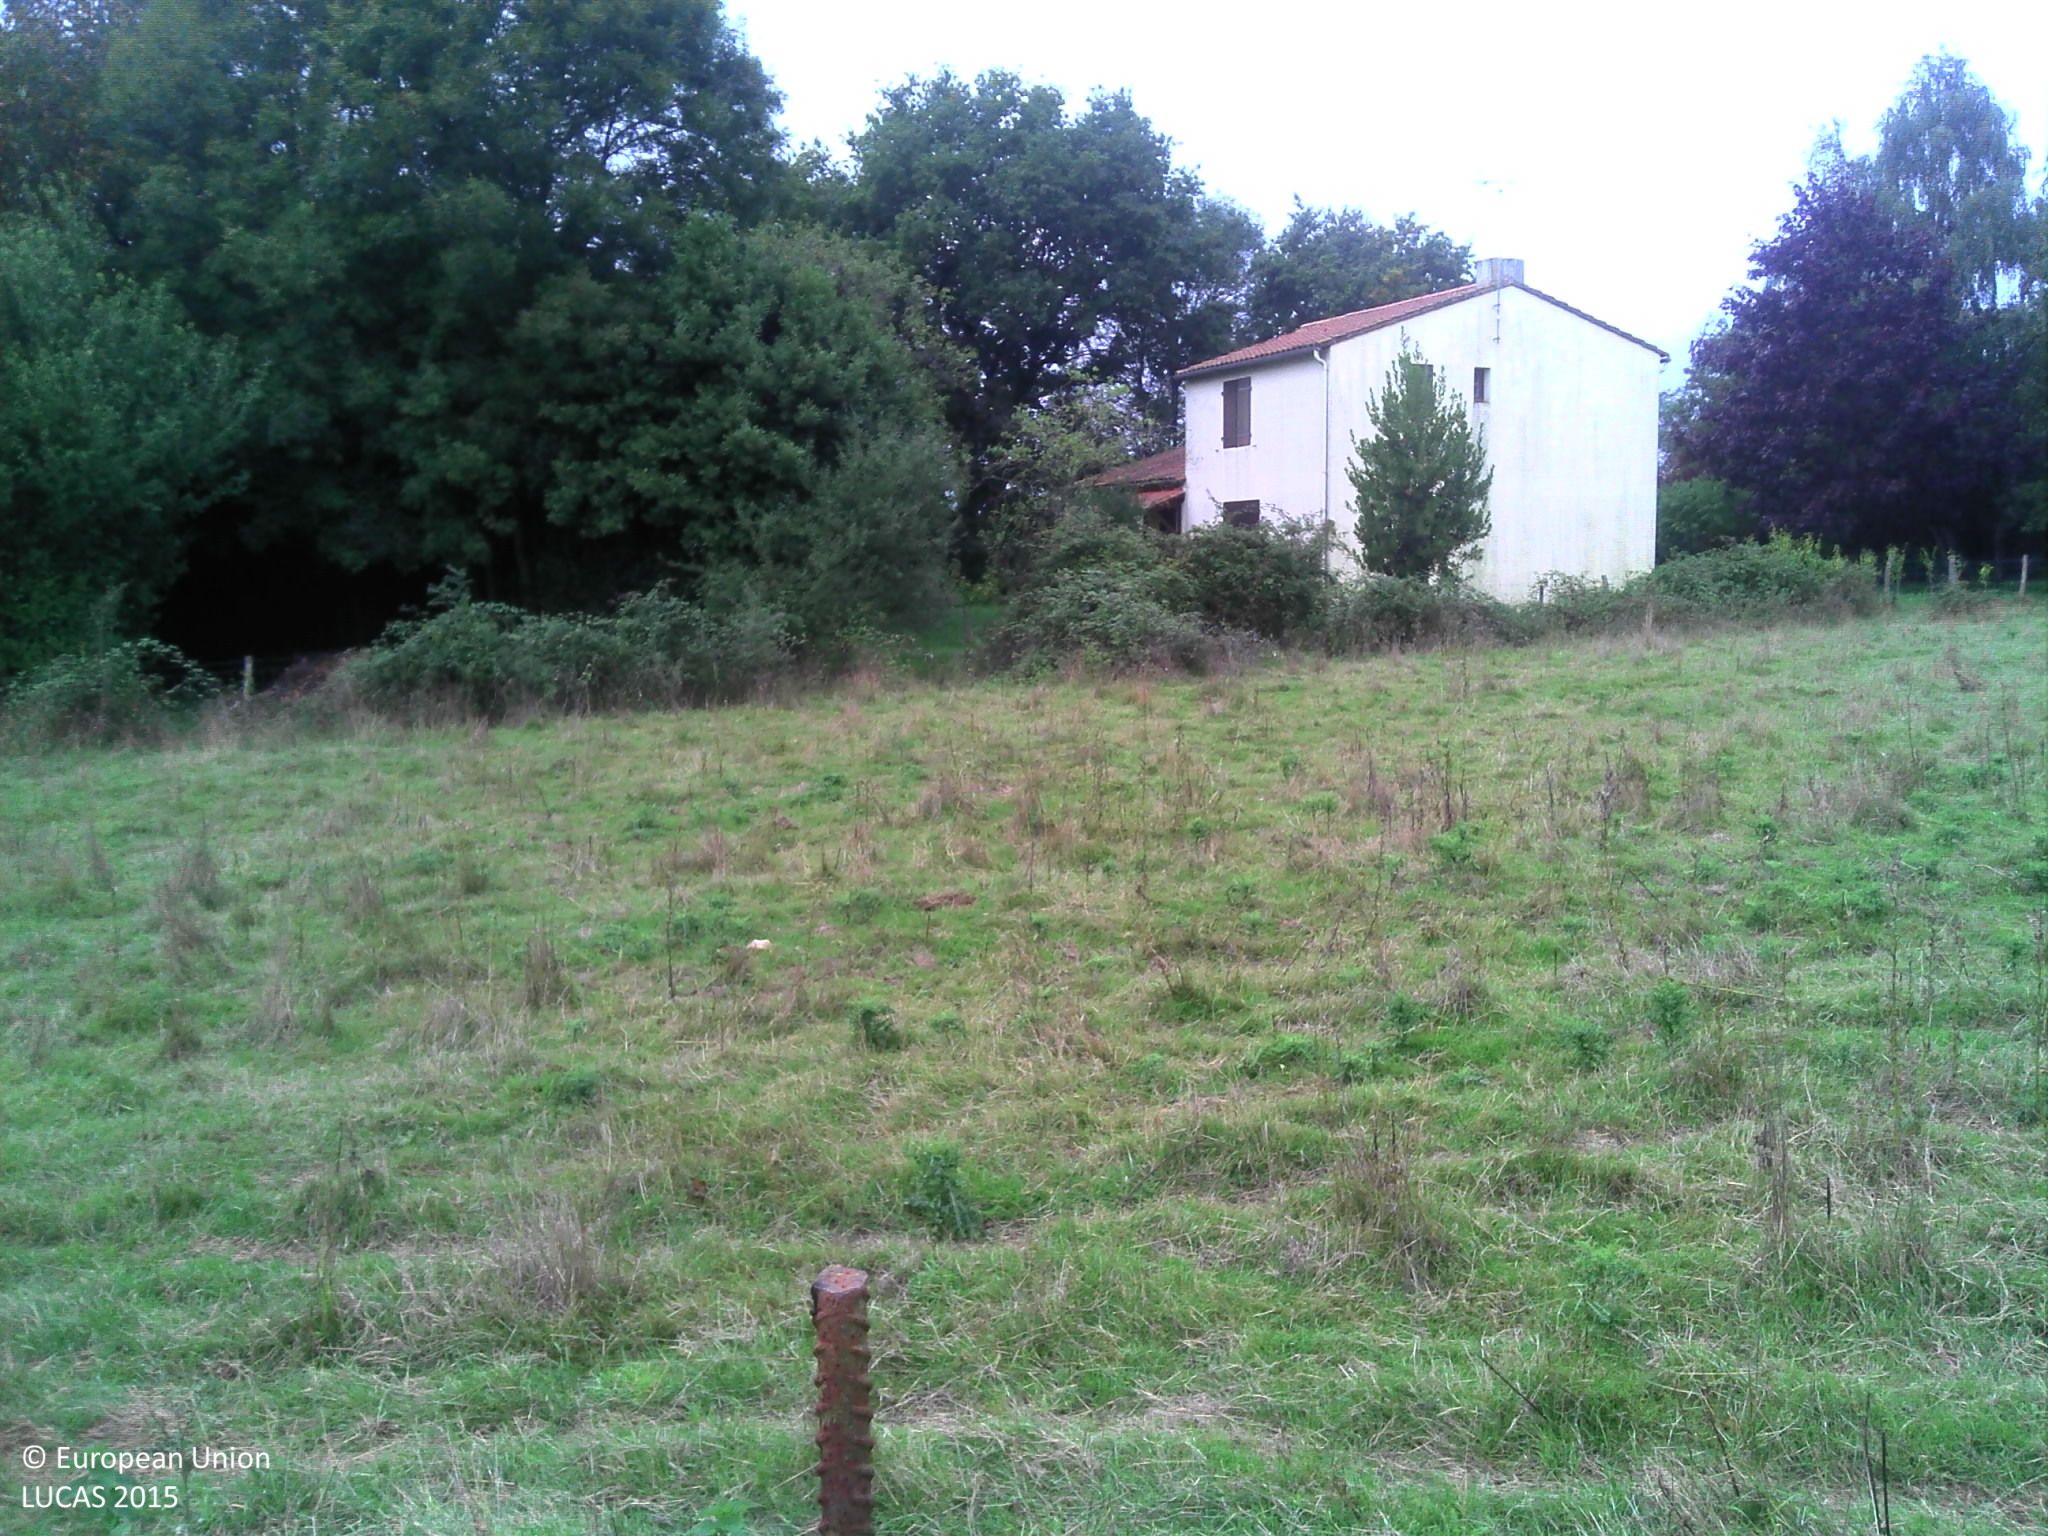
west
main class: Grassland
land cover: Grassland without tree/shrub cover
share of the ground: > 75 %
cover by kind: herbaceous plants 100 %
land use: Agriculture (excluding fallow land and kitchen gardens)
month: September
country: FR
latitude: 46.6492
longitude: -1.0478
